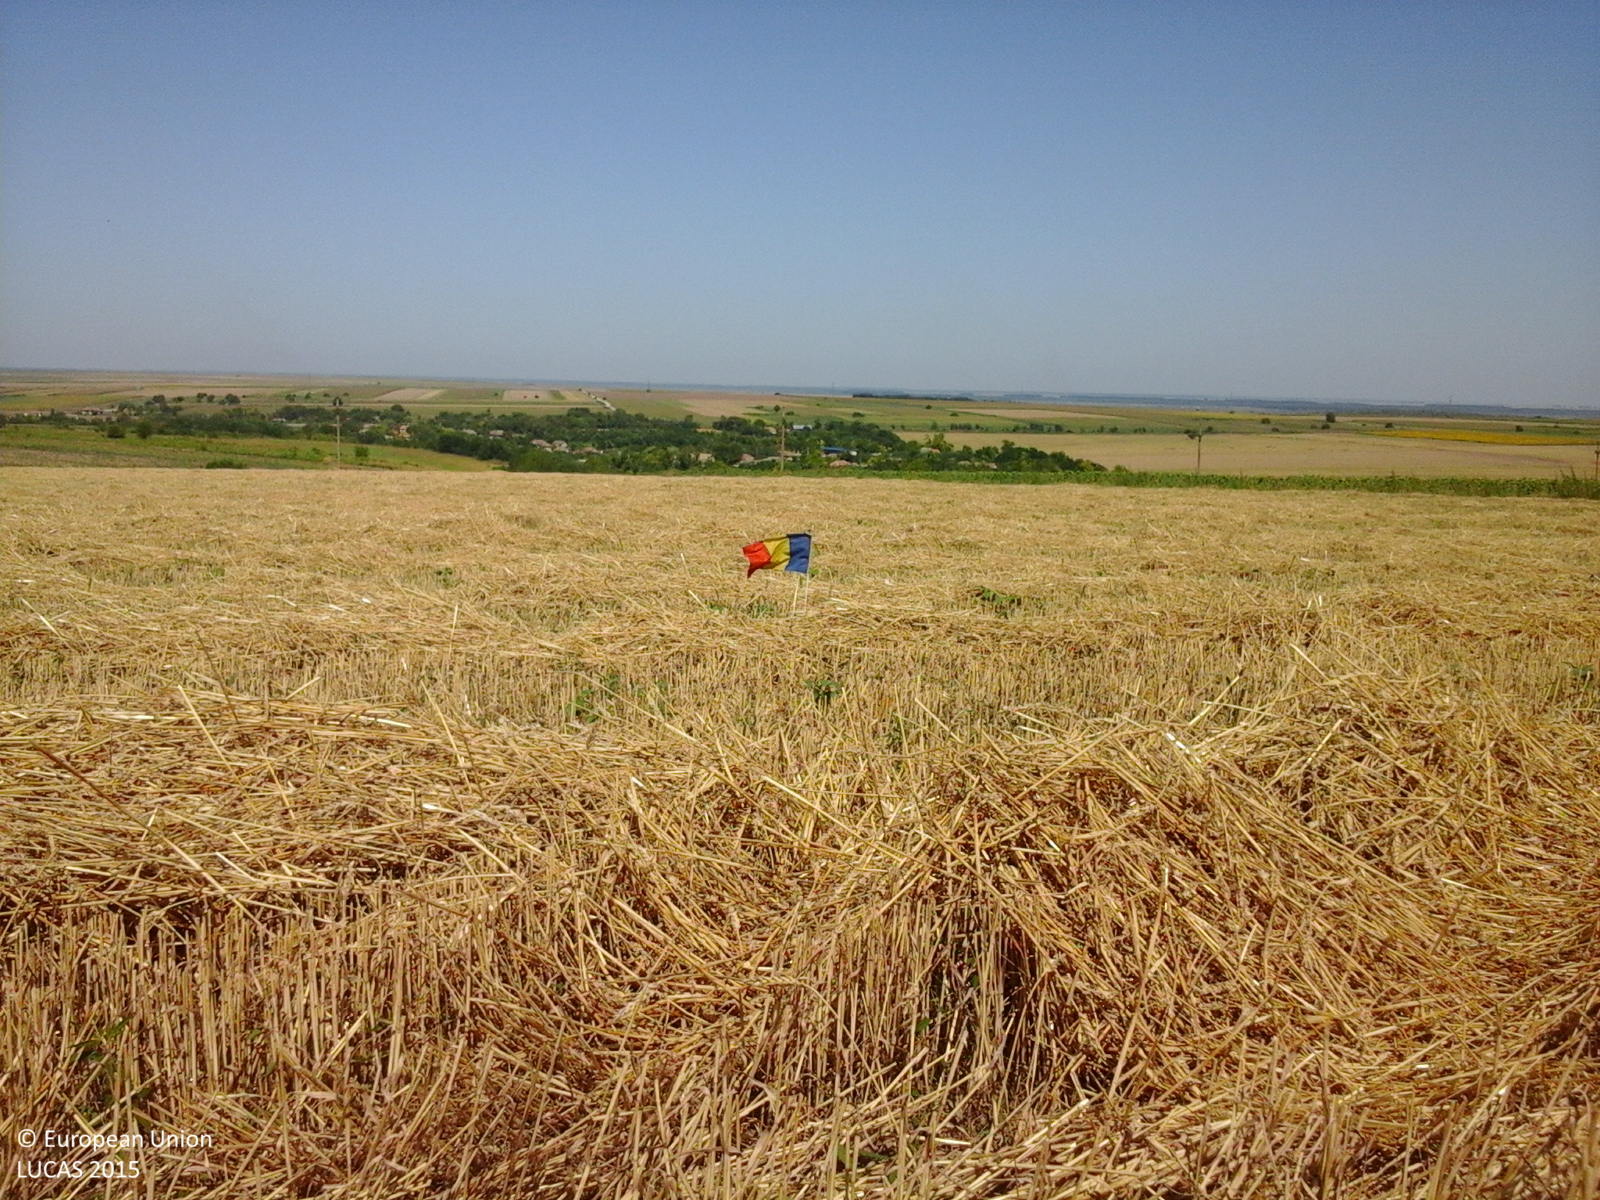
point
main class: Cropland
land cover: Common wheat
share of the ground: 50 - 75 %
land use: Agriculture (excluding fallow land and kitchen gardens)
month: August
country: RO
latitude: 44.6812
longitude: 28.0903
